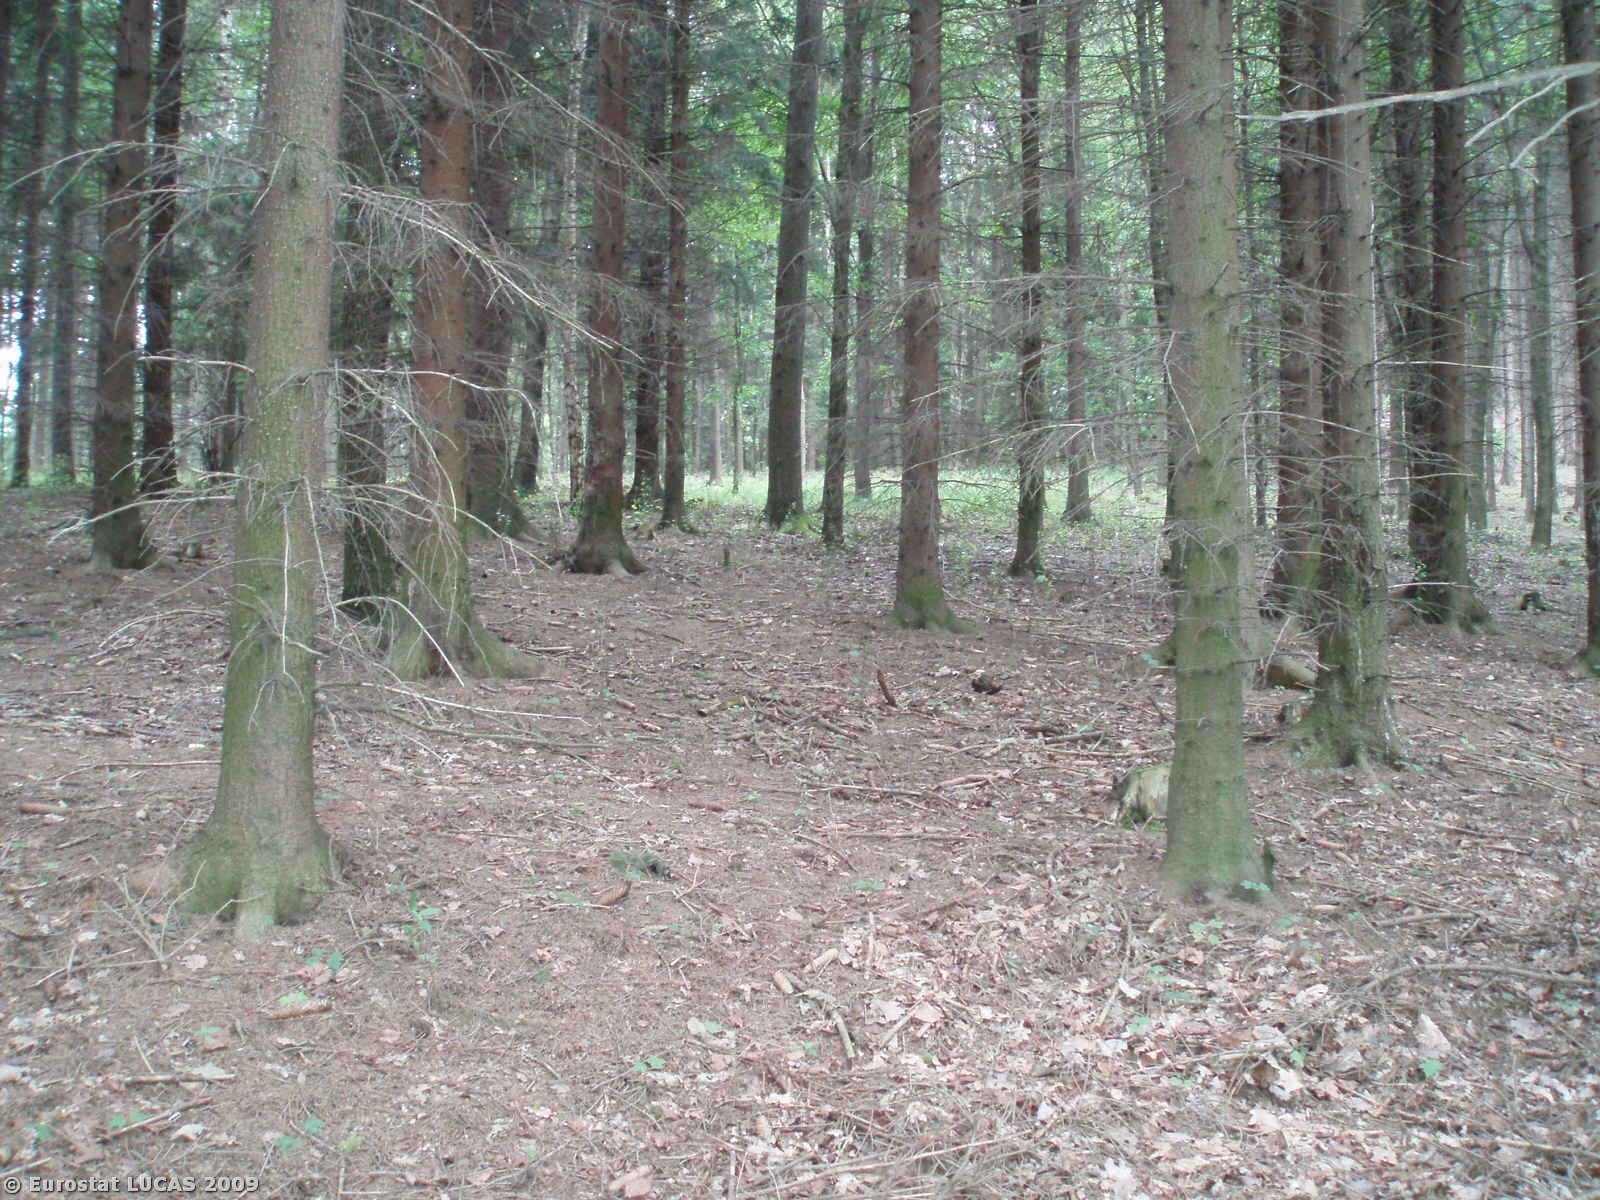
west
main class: Woodland
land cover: Coniferous woodland
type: hemiboreal forest and nemoral coniferous forest and mixed broadleaved-coniferous forest
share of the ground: > 75 %
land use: Forestry
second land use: Nature reserves
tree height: > 5 m
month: July
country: CZ
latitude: 50.7972
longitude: 14.9543
